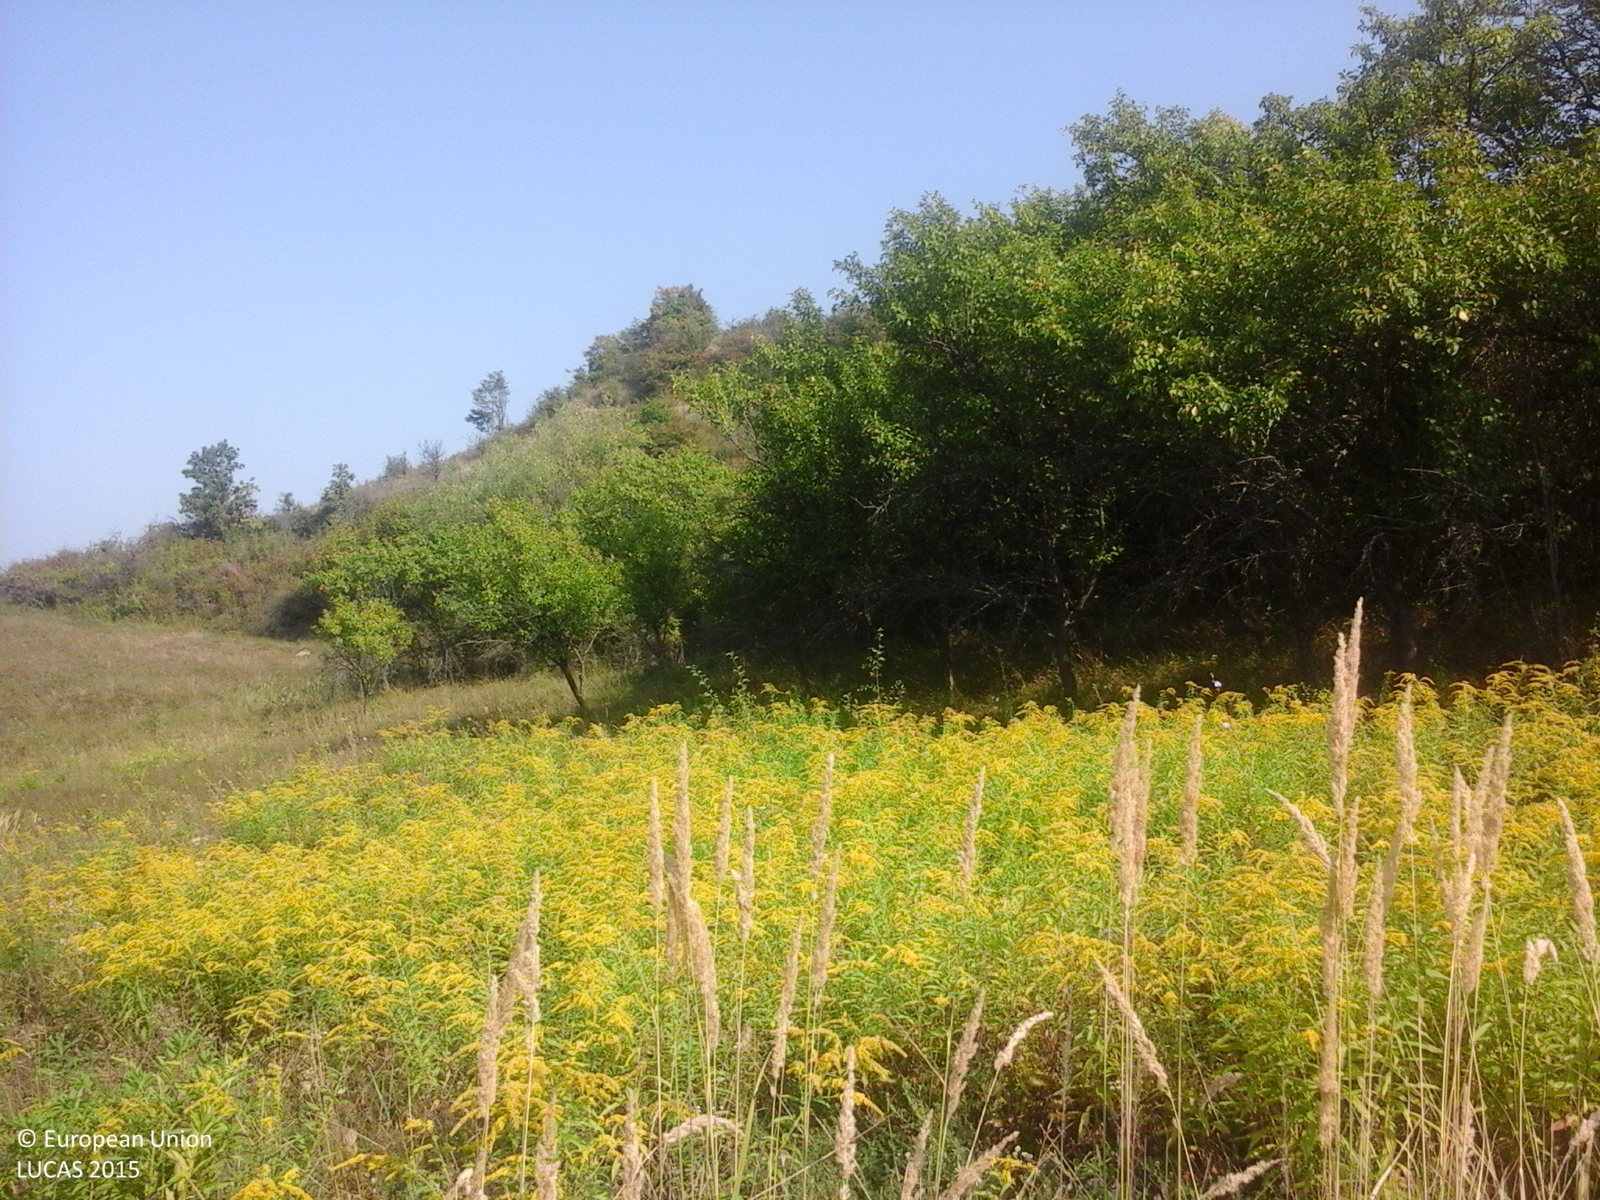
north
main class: Grassland
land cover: Spontaneously vegetated surfaces
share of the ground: > 75 %
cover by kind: herbaceous plants 100 %
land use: Fallow land
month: September
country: RO
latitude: 47.1478
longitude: 24.3705
